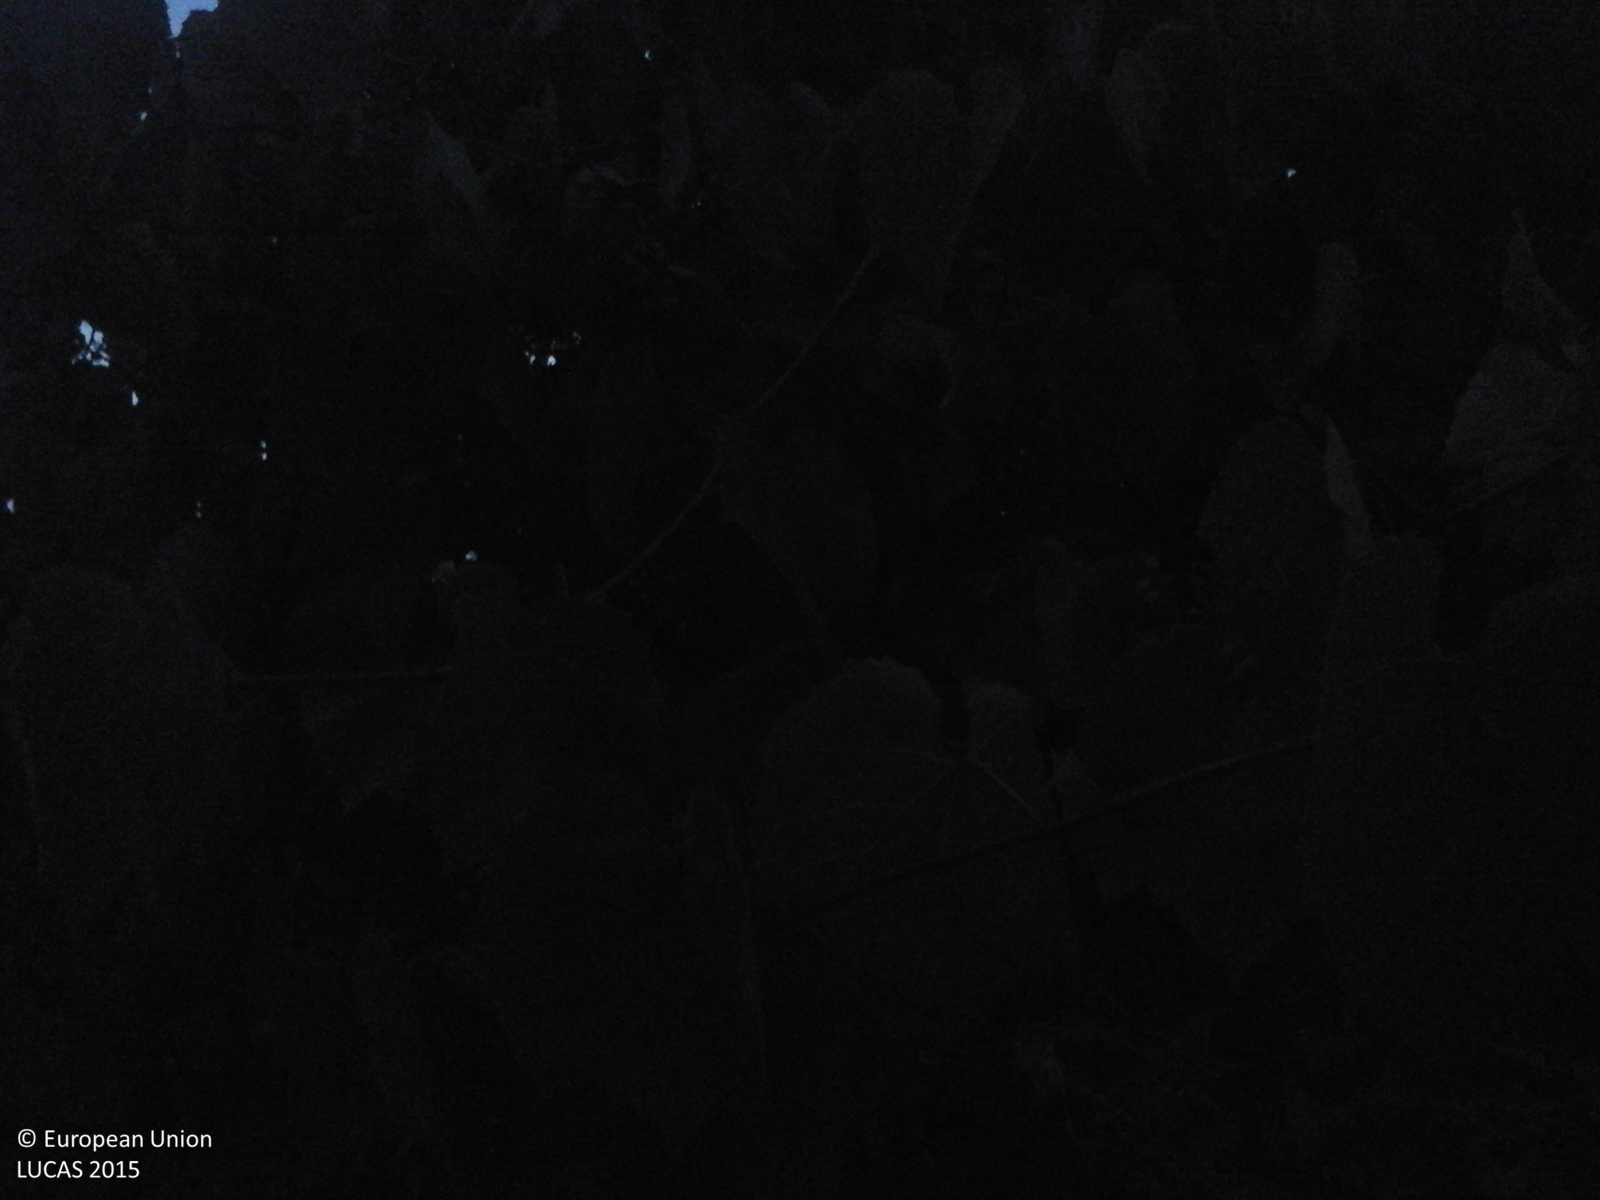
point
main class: Cropland
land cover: Vineyards
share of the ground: > 75 %
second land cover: Shrubland without tree cover
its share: > 75 %
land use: Abandoned areas
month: August
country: RO
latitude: 44.3239
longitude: 28.0251
